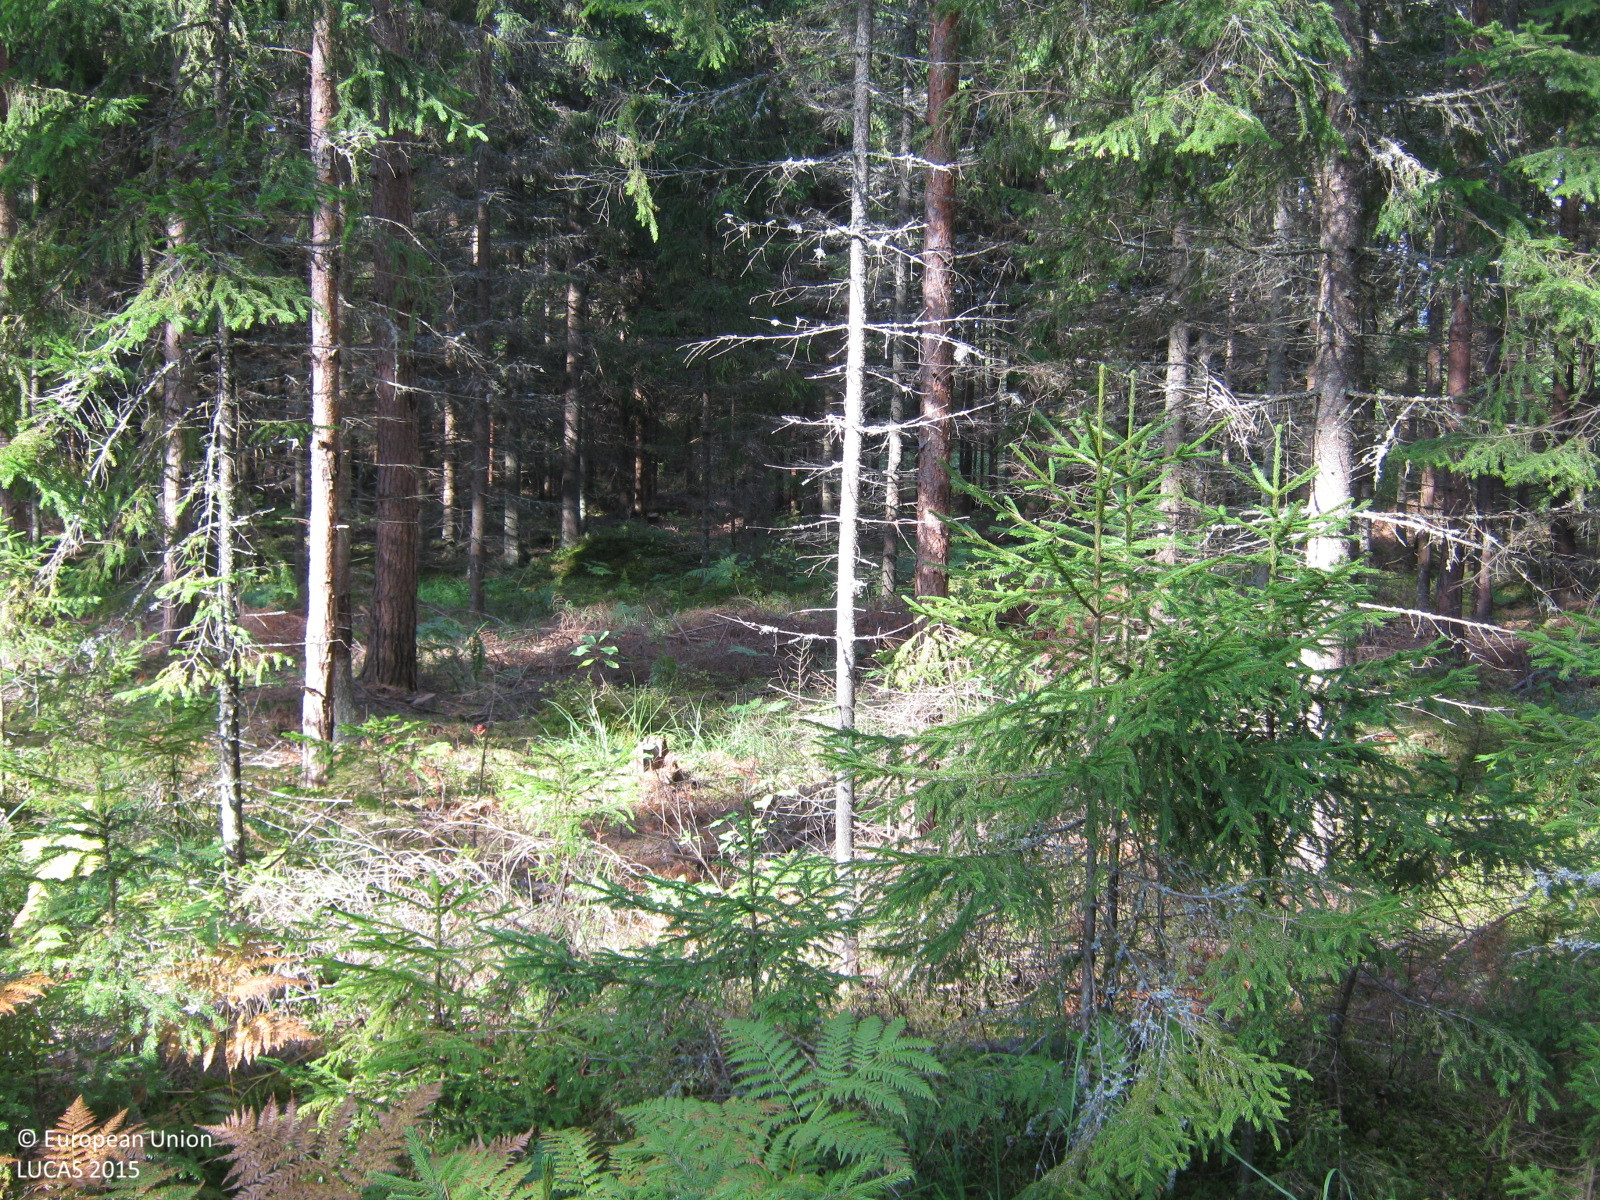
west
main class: Woodland
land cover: Other coniferous woodland
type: hemiboreal forest and nemoral coniferous forest and mixed broadleaved-coniferous forest
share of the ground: > 75 %
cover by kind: coniferous forest trees 80 %, shrubs 10 %, lichens and mosses 10 %
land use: Forestry
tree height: > 5 m
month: September
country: LV
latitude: 57.3045
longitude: 24.4487
